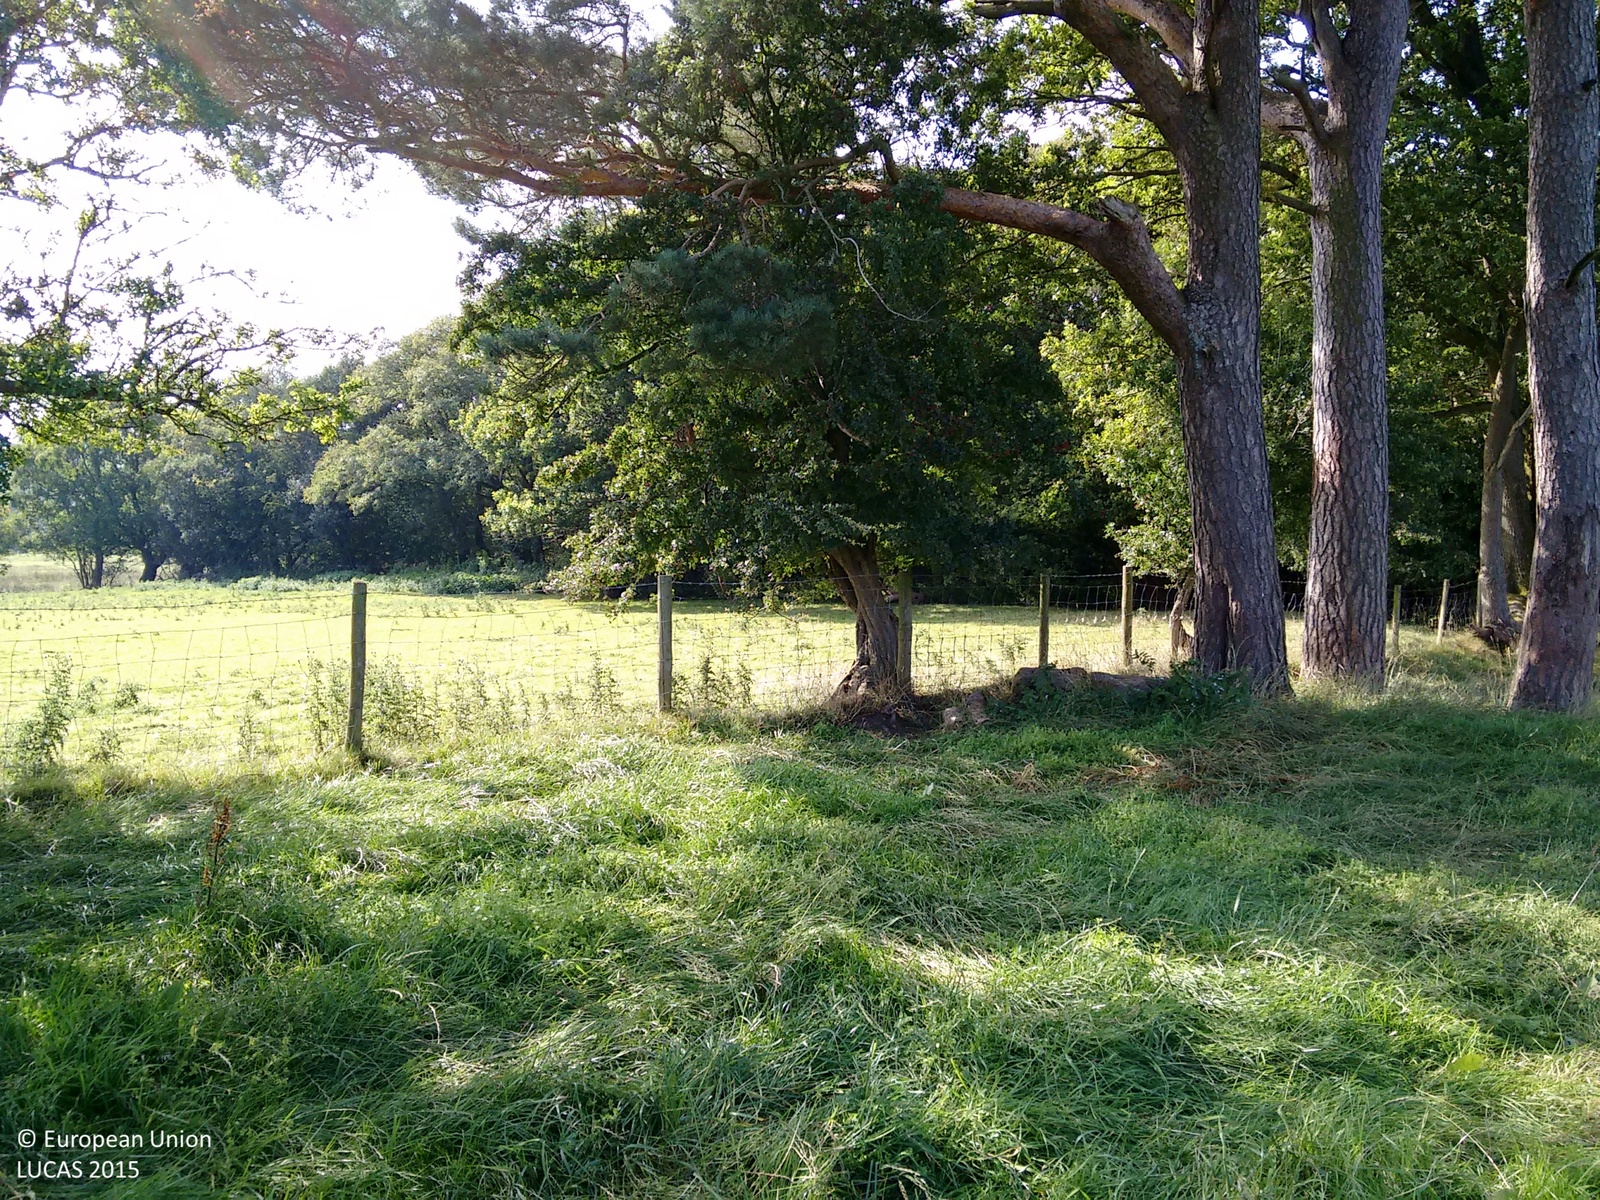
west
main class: Grassland
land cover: Grassland without tree/shrub cover
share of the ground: > 75 %
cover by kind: herbaceous plants 100 %
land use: Agriculture (excluding fallow land and kitchen gardens)
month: September
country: GB
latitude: 51.9181
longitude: -3.4450
